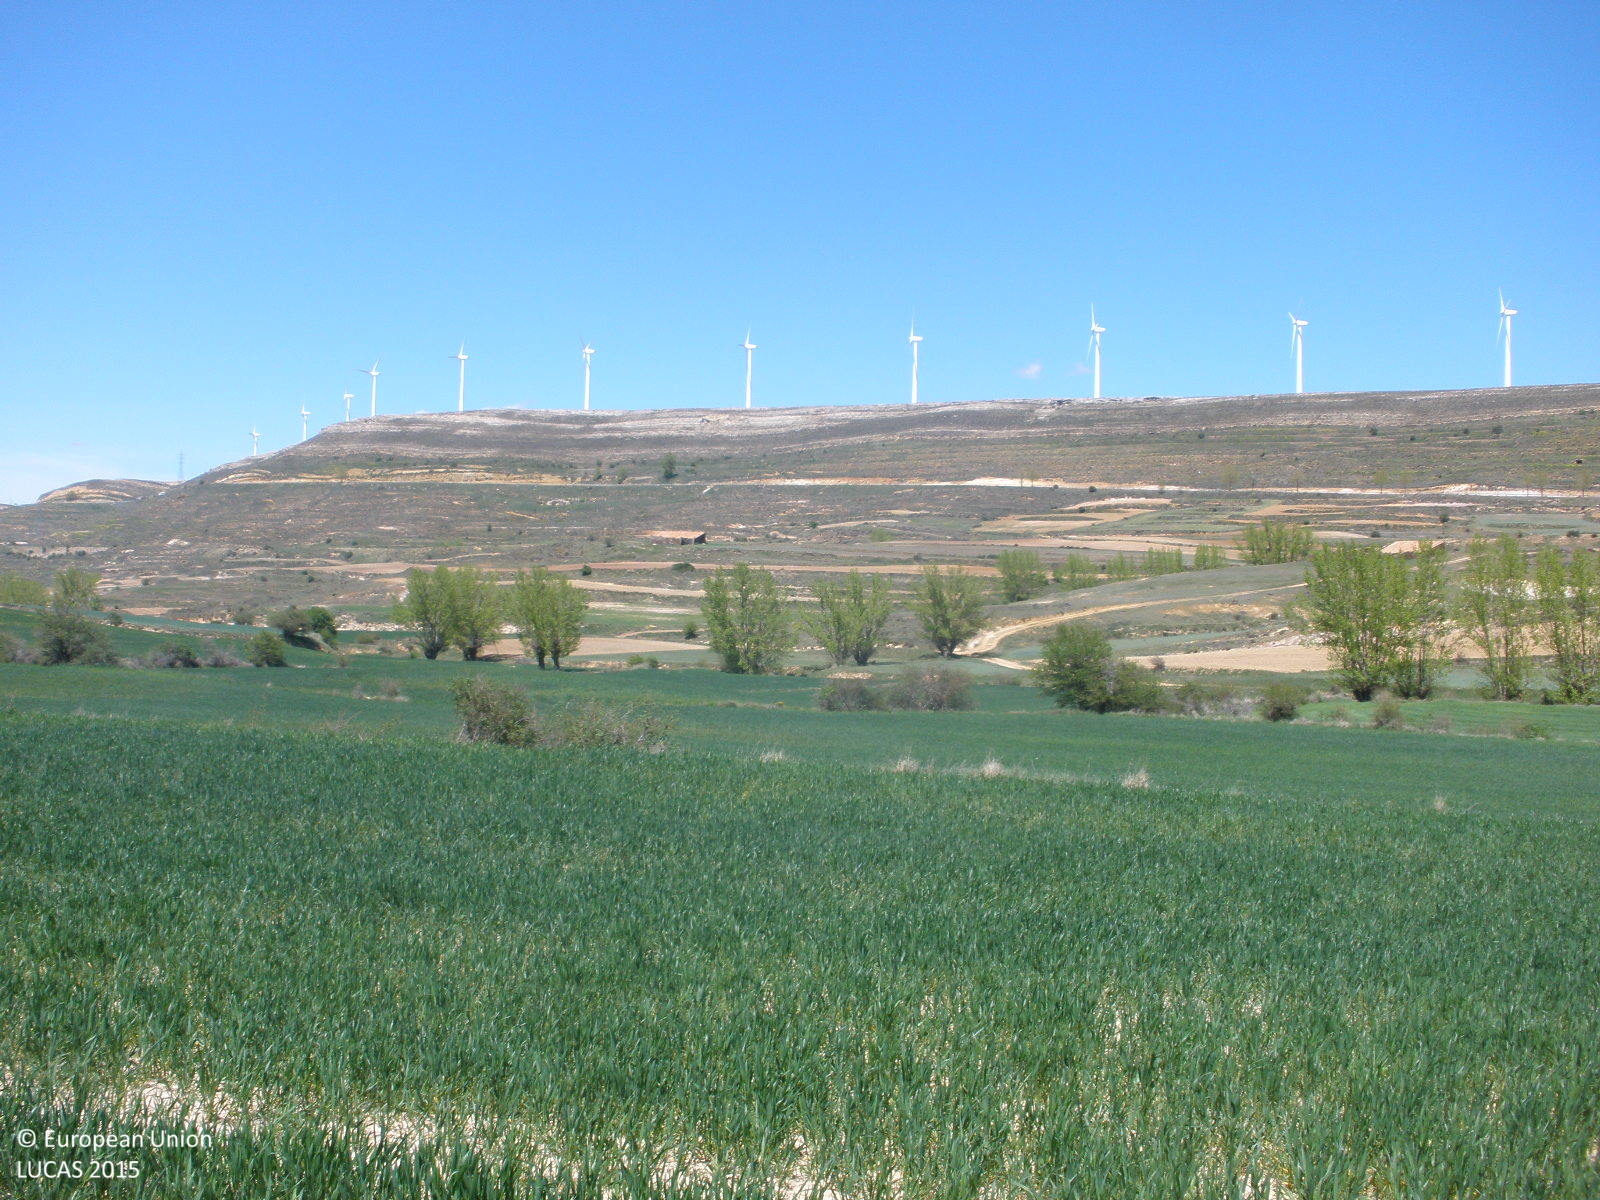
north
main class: Cropland
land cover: Durum wheat
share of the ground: 50 - 75 %
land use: Agriculture (excluding fallow land and kitchen gardens)
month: May
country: ES
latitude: 40.7577
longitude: -0.8514
